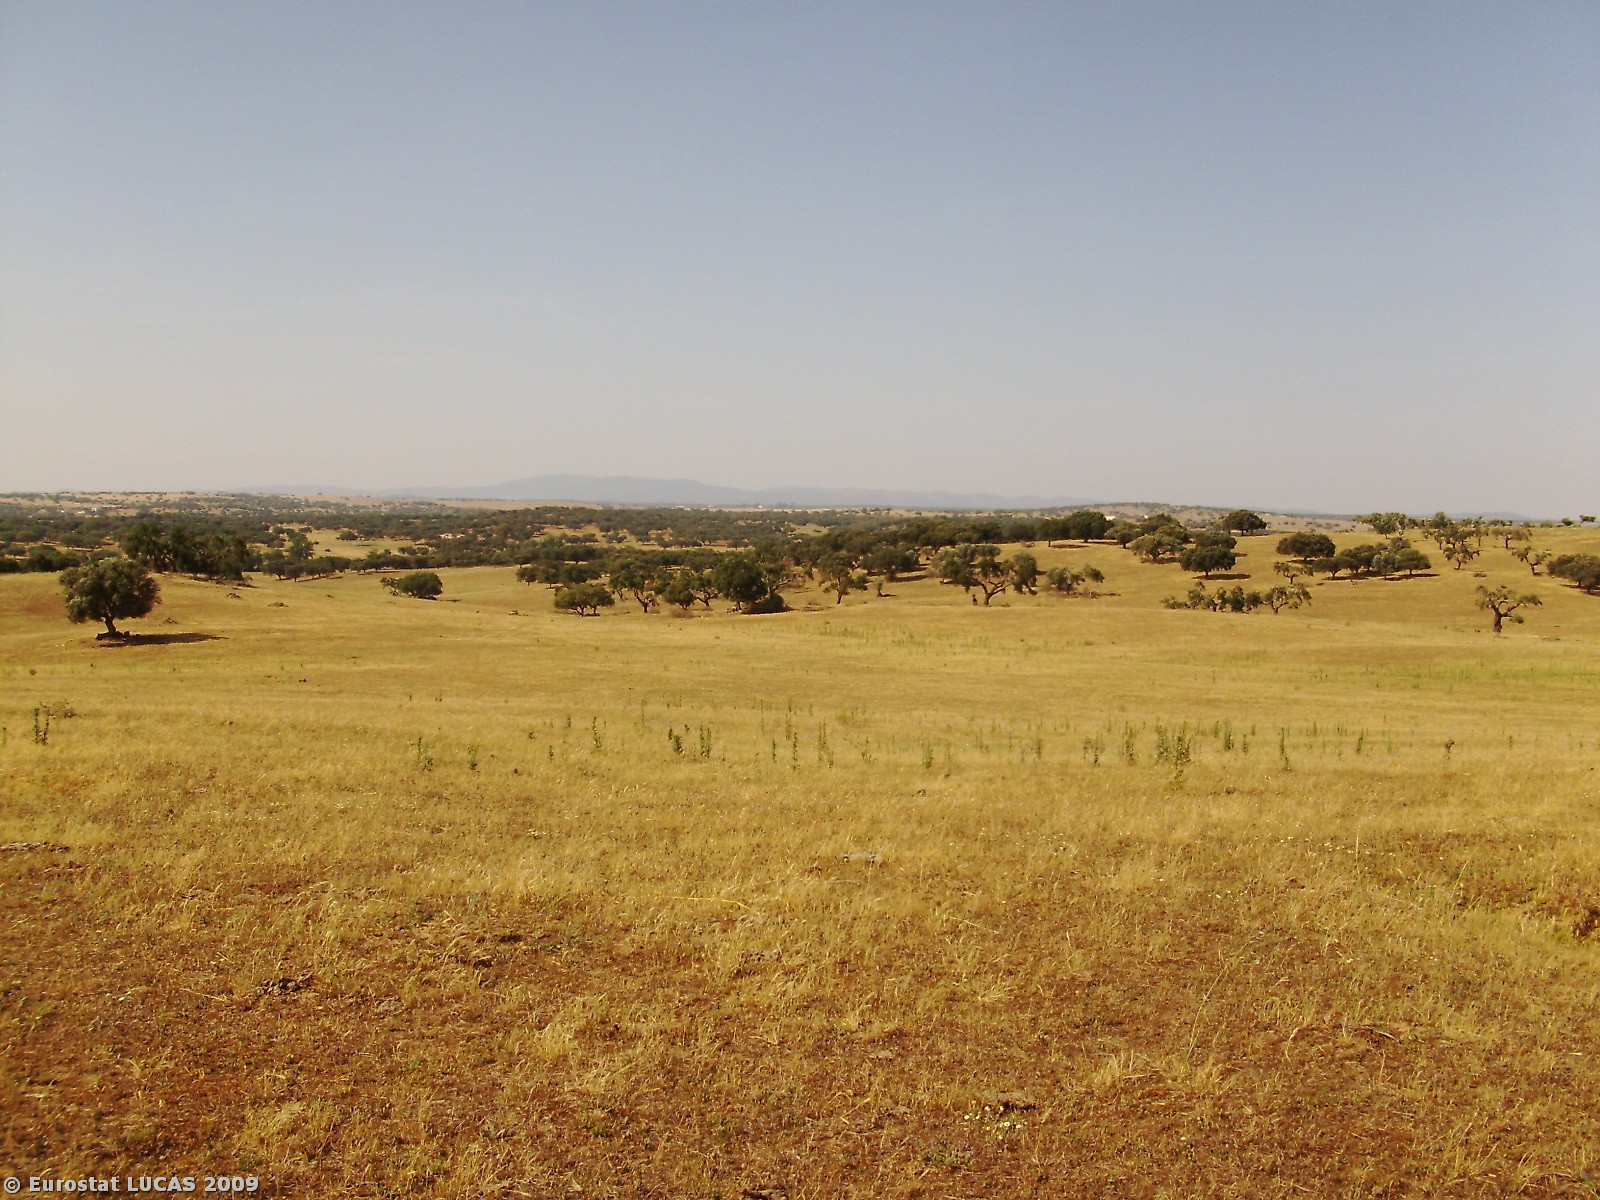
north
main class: Grassland
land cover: Grassland without tree/shrub cover
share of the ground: > 75 %
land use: Agriculture (excluding fallow land and kitchen gardens)
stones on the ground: 10 - 25 %
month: June
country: PT
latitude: 39.0667
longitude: -7.4079
